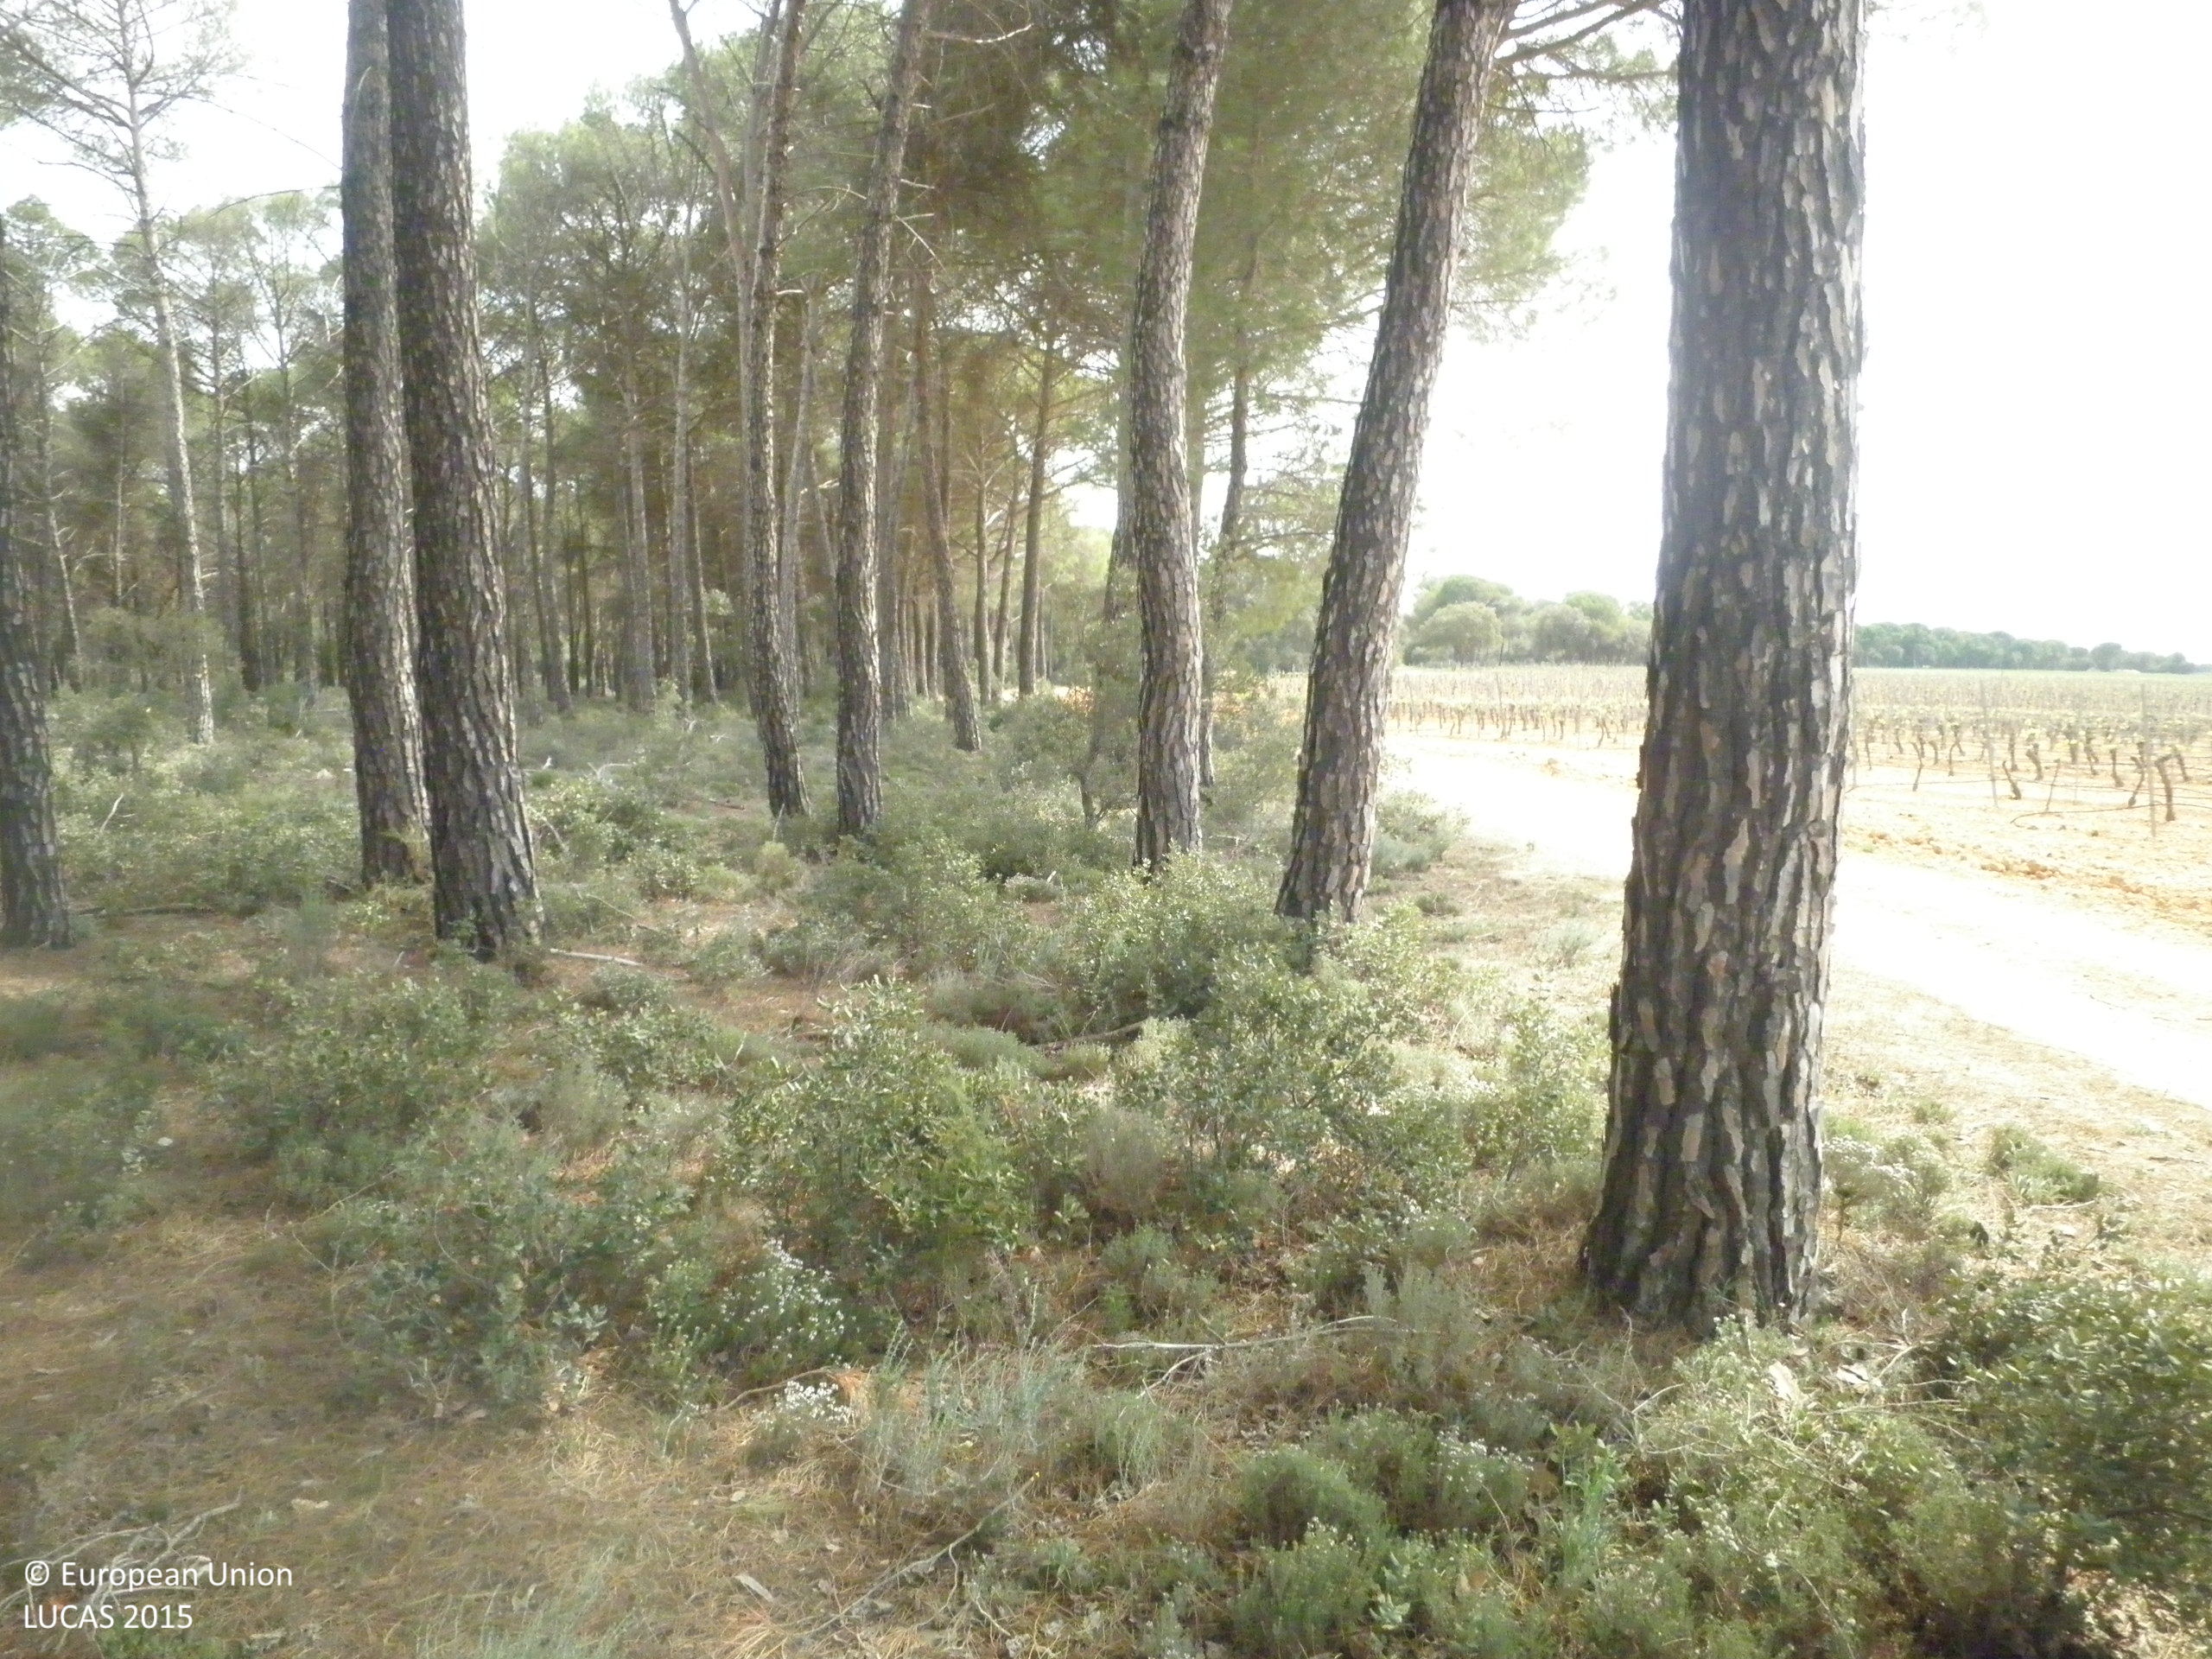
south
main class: Woodland
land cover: Pine dominated coniferous woodland
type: coniferous forest of the mediterranean region
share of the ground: > 75 %
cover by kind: coniferous forest trees 70 %, shrubs 10 %, herbaceous plants 10 %, unconsolidated bare surface 10 %
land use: Semi-natural and natural areas not in use
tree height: > 5 m
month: April
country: ES
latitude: 39.3862
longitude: -2.6789
